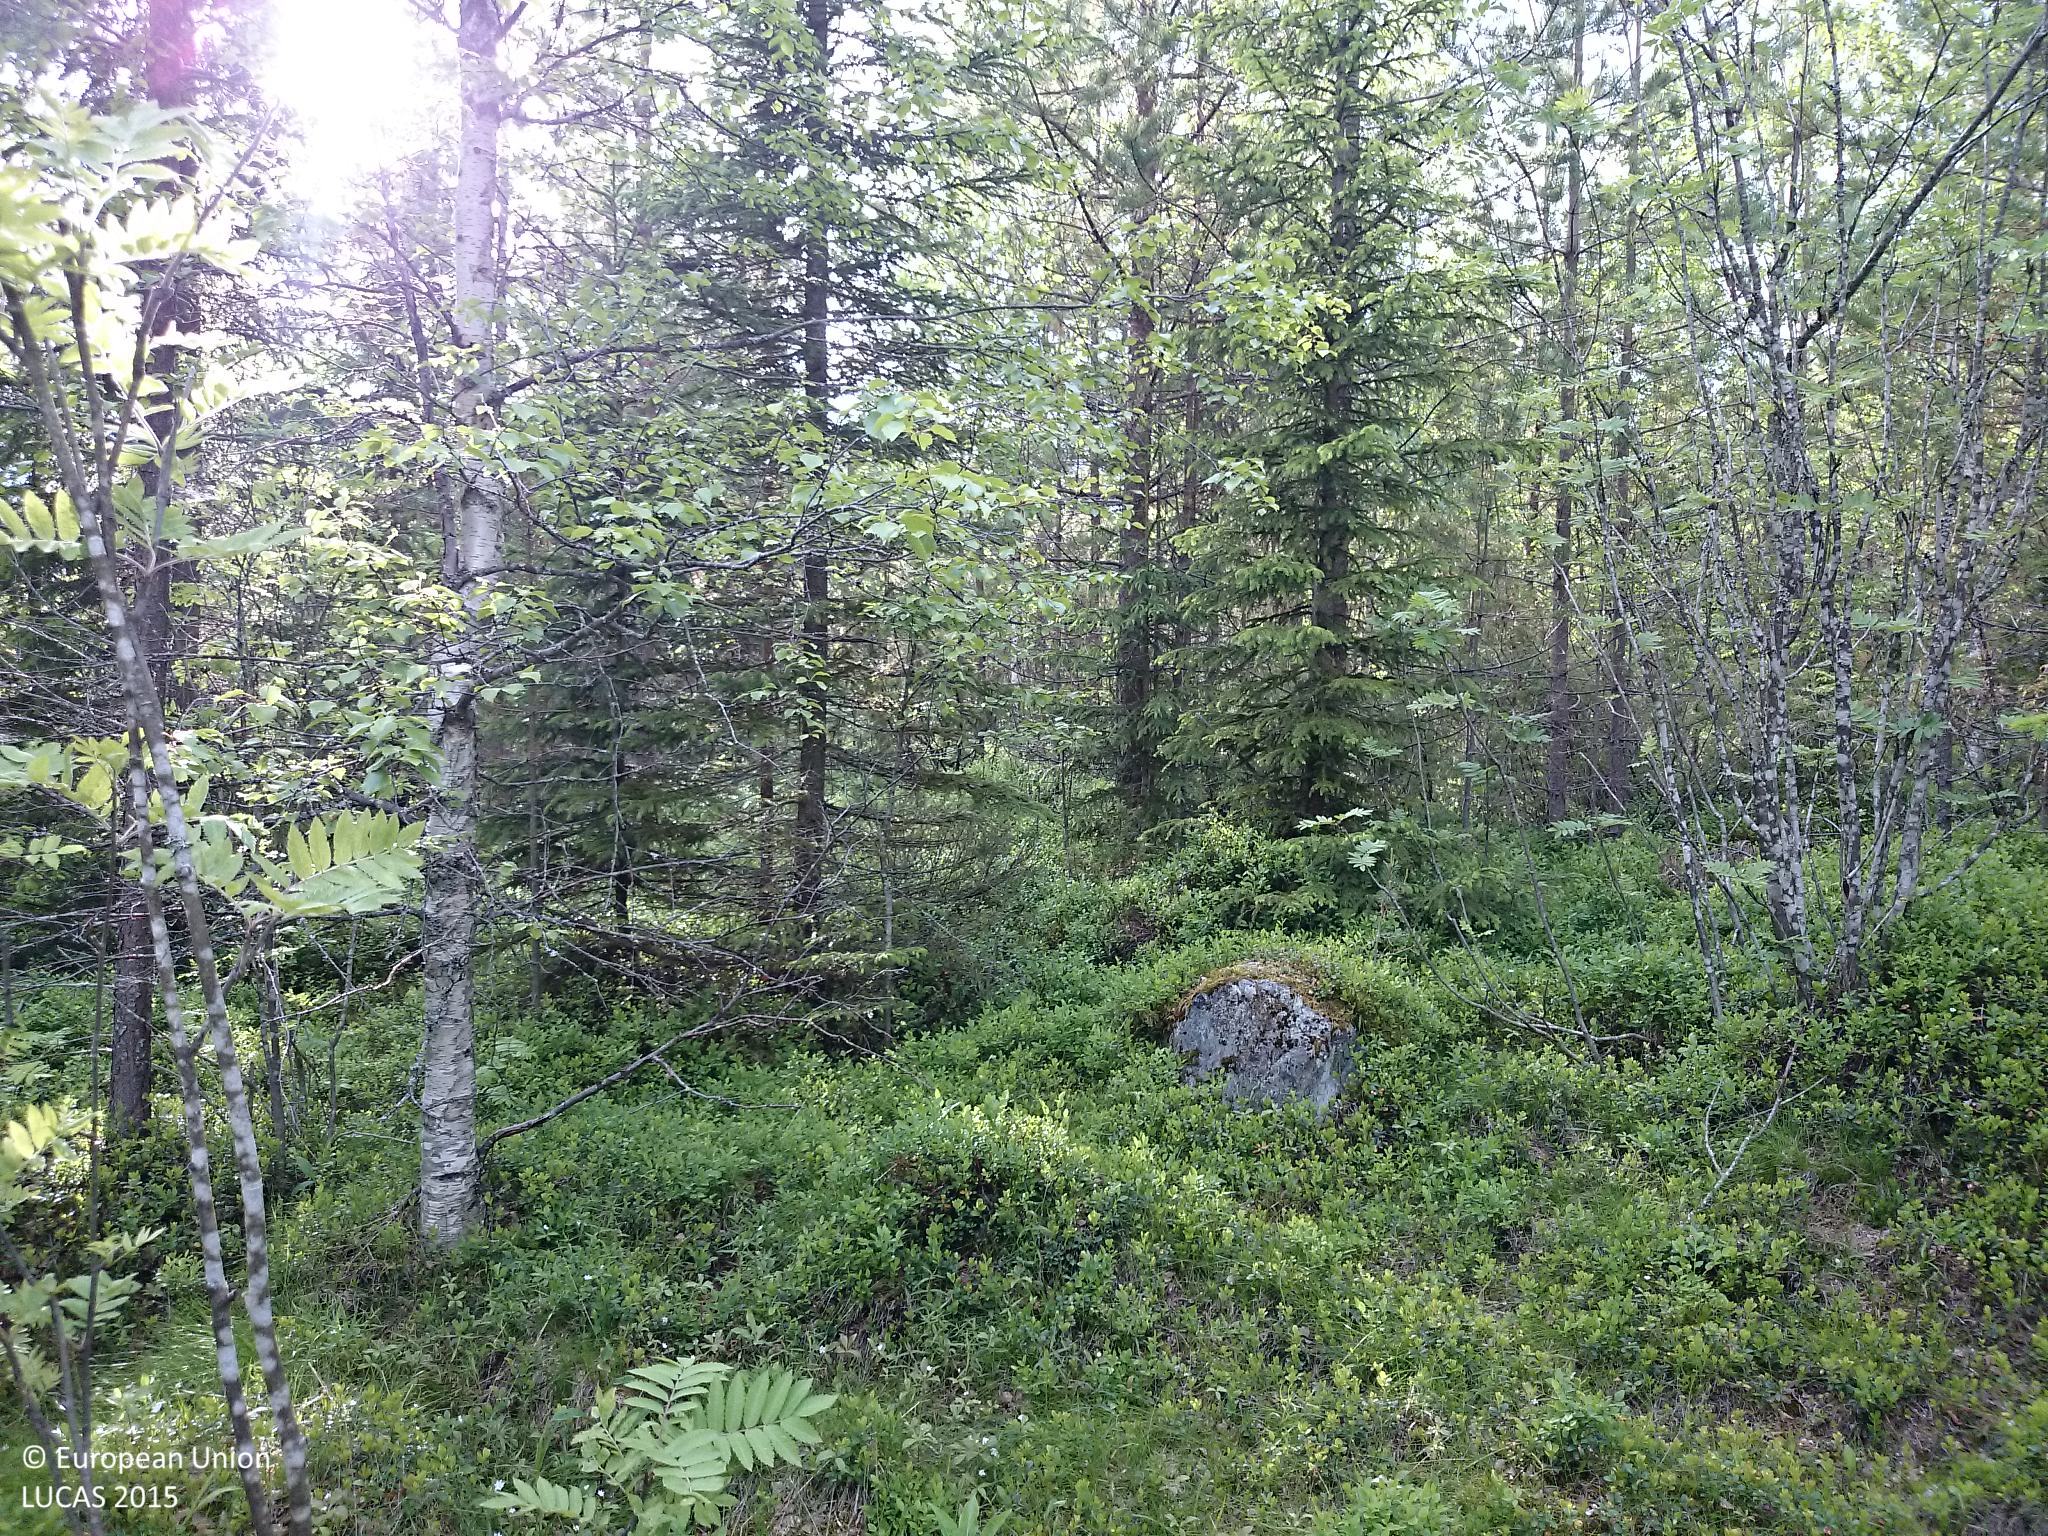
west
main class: Woodland
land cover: Other mixed woodland
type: boreal forest
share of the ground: 50 - 75 %
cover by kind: coniferous forest trees 45 %, shrubs 25 %, broadleaved forest trees 15 %, herbaceous plants 15 %
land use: Forestry
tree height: > 5 m
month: June
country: SE
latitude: 64.1910
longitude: 20.8316
